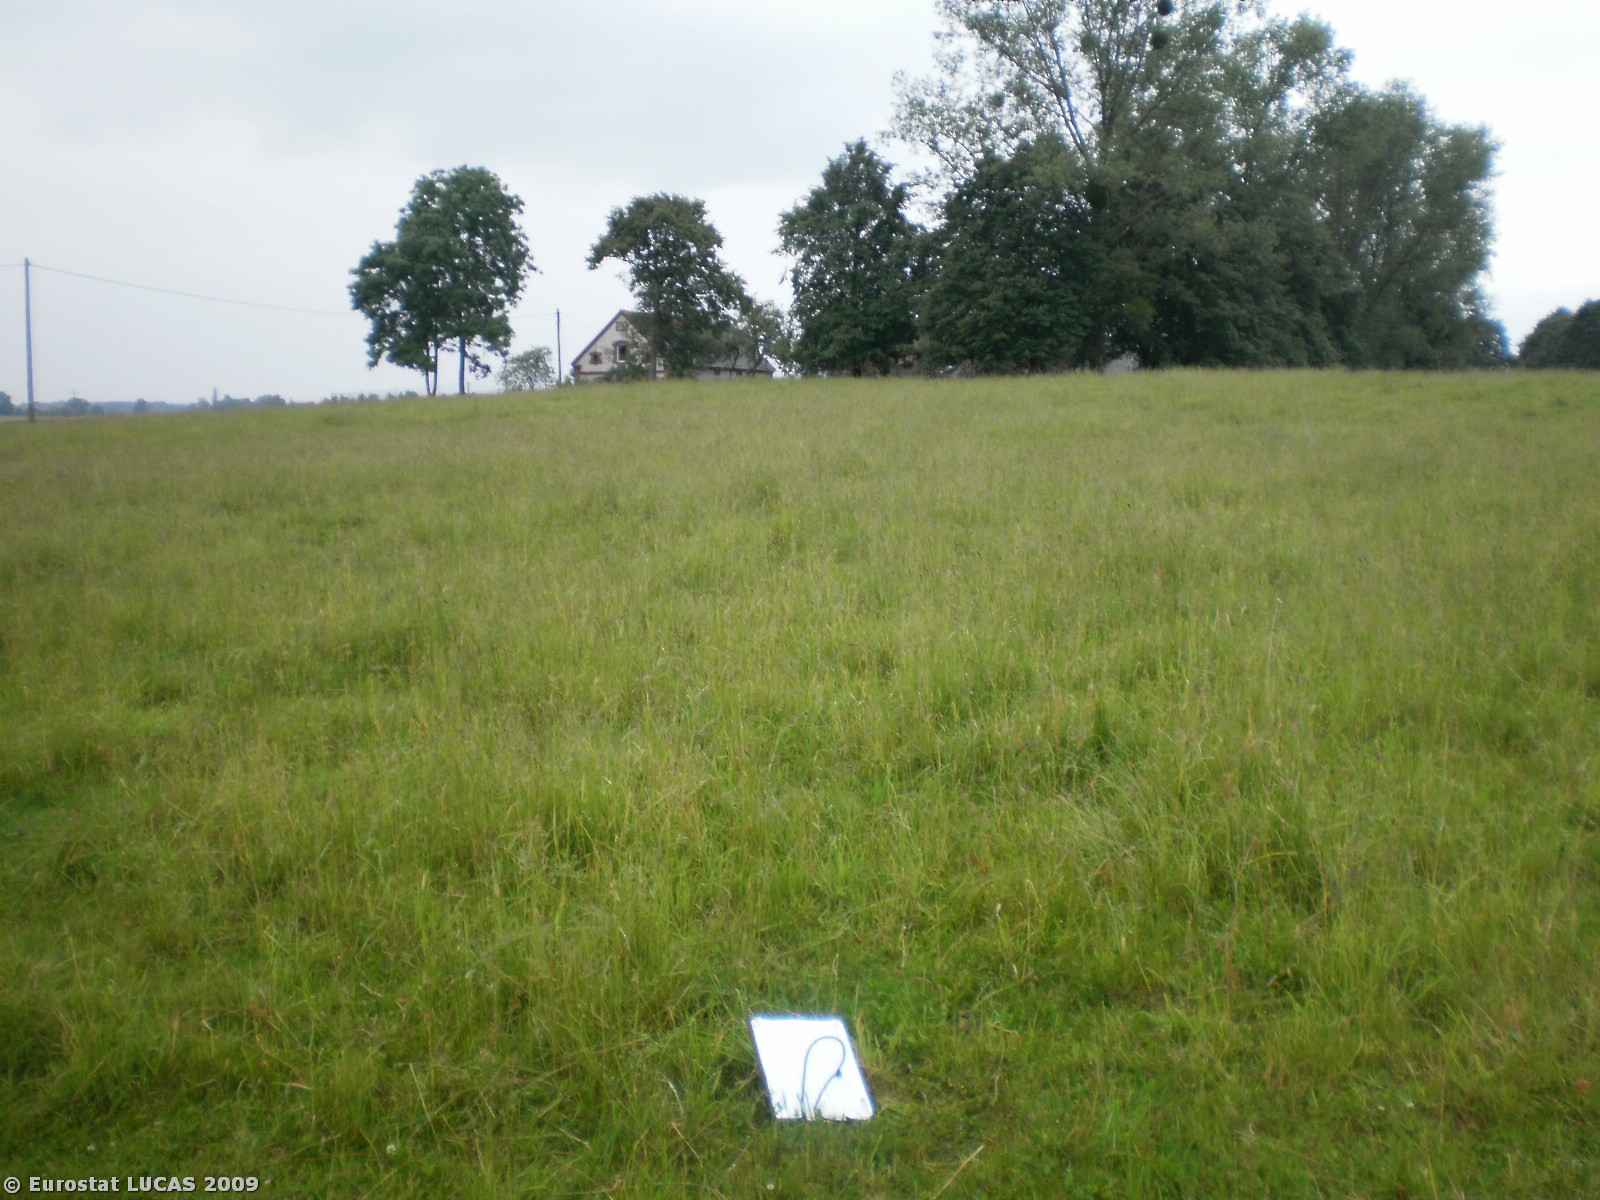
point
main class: Grassland
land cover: Grassland without tree/shrub cover
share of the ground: > 75 %
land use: Agriculture (excluding fallow land and kitchen gardens)
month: June
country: PL
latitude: 53.5935
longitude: 19.8965
